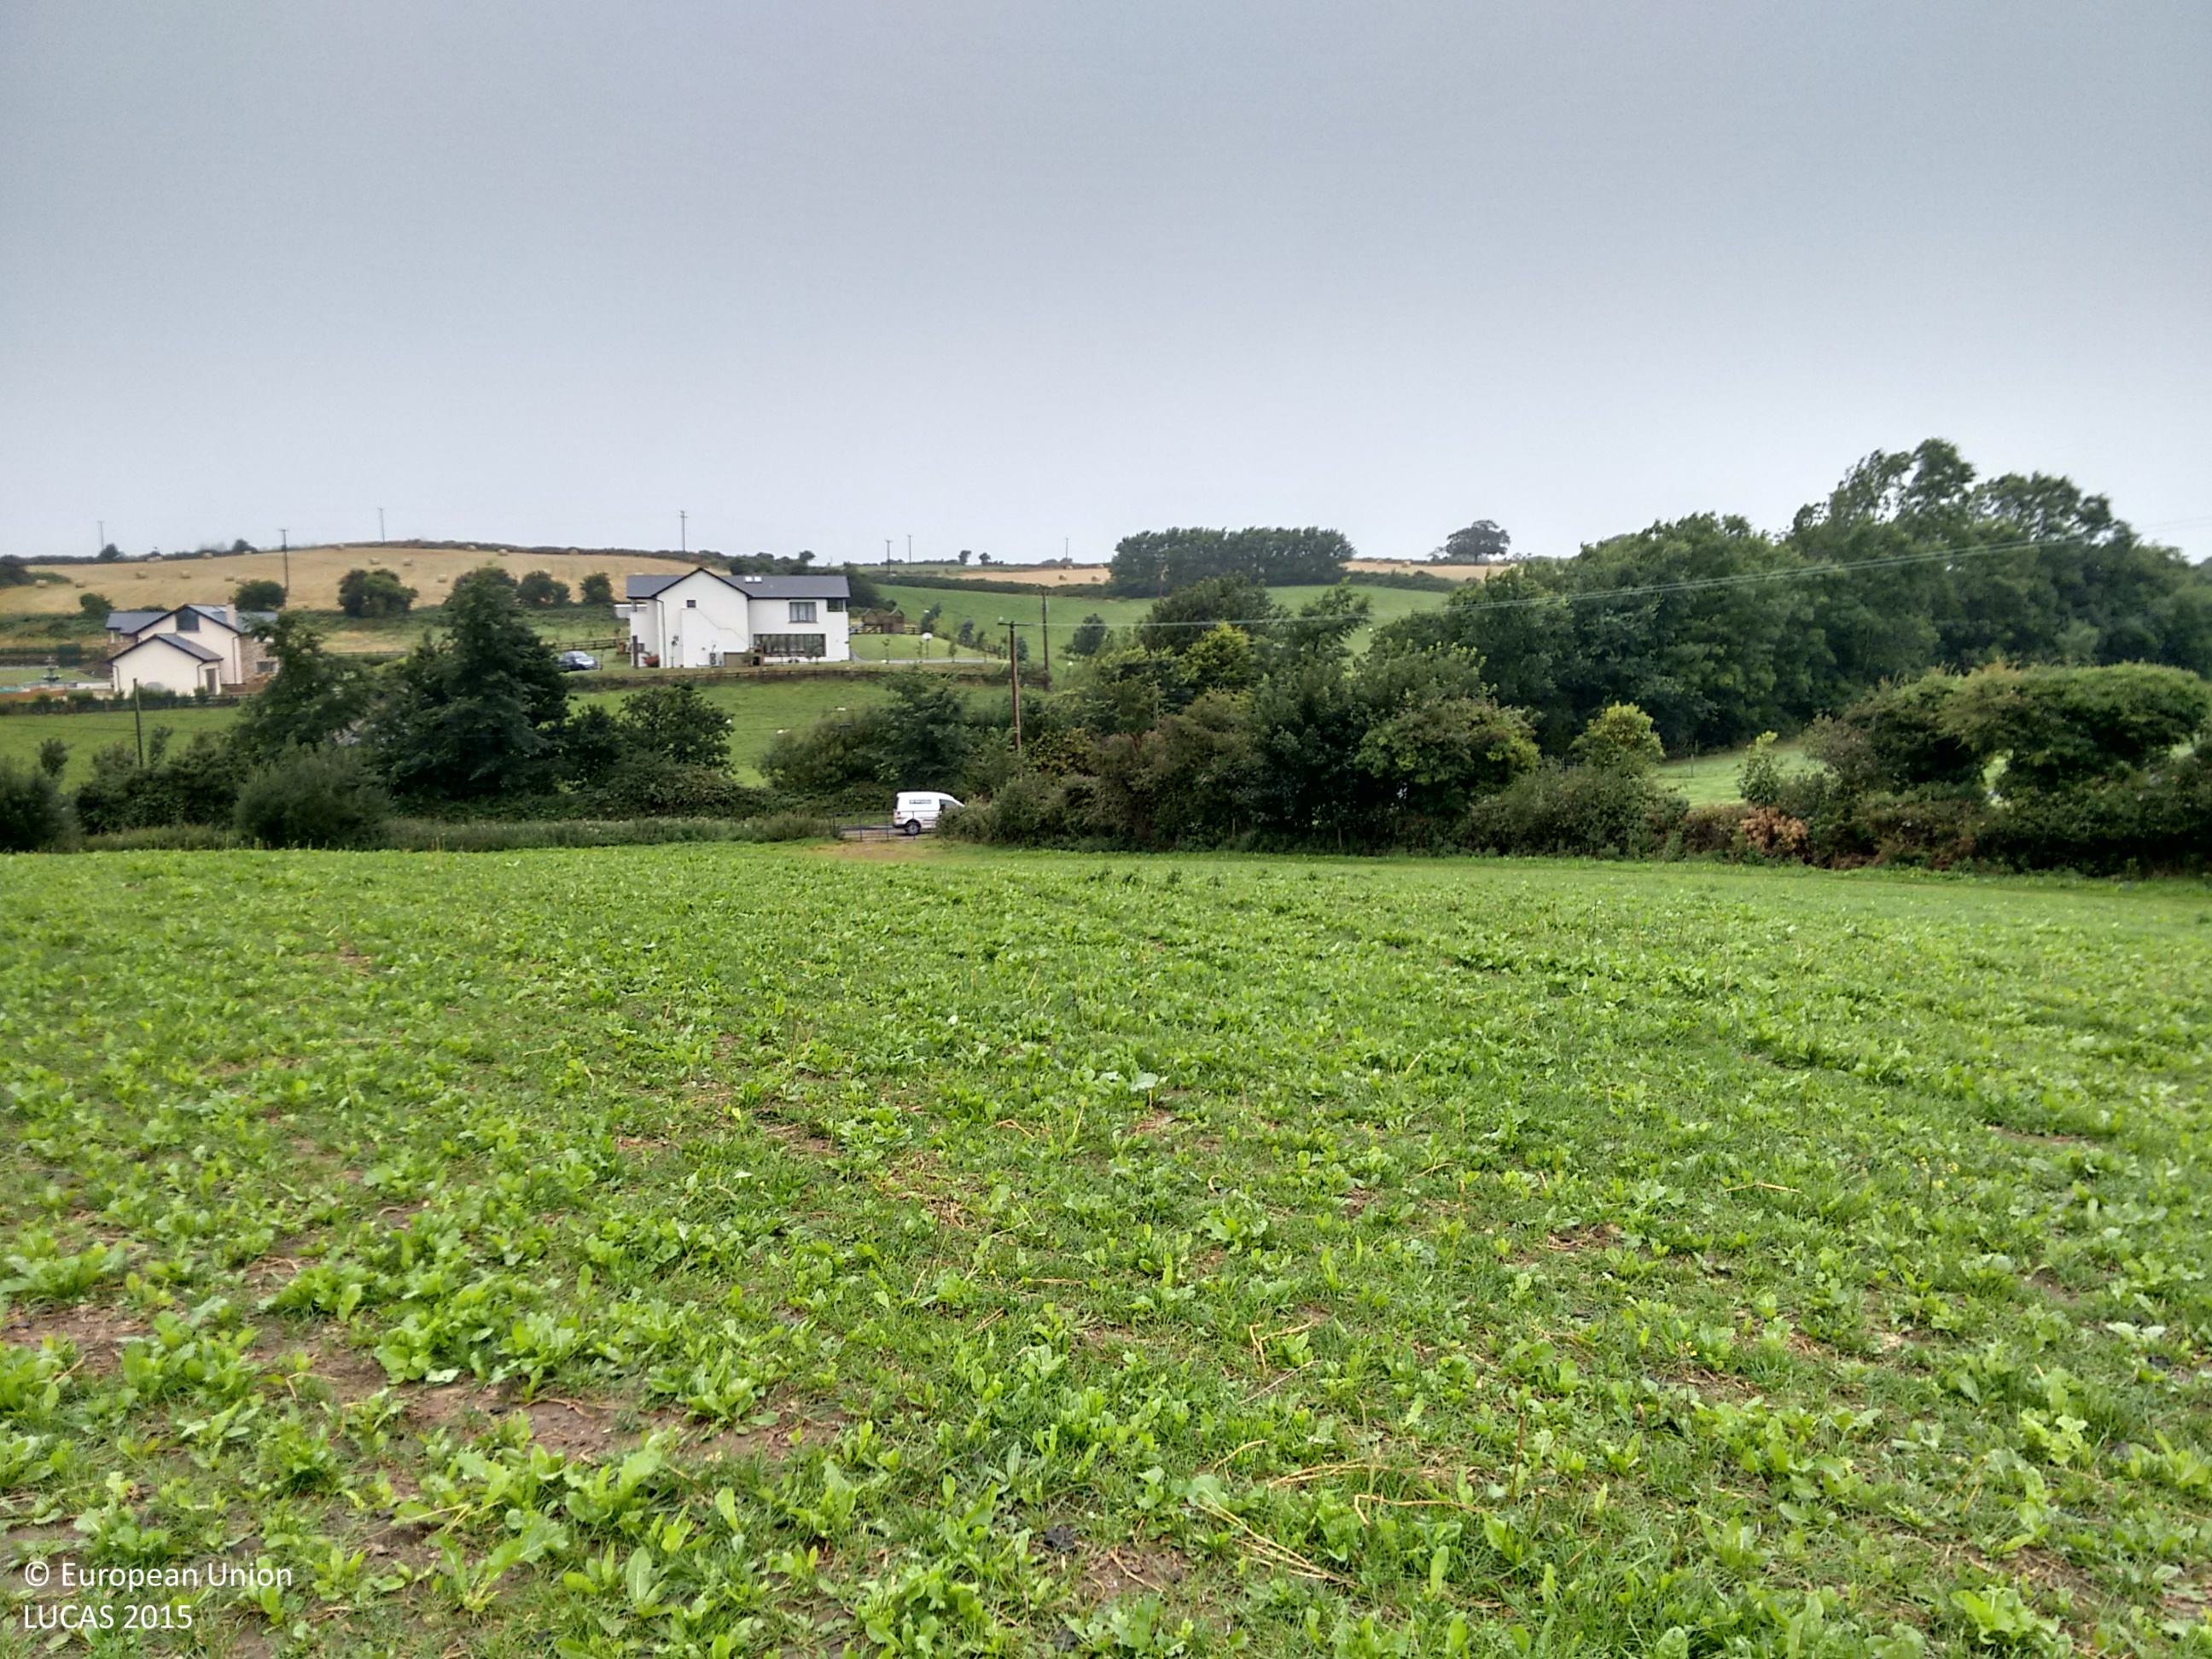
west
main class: Grassland
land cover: Spontaneously vegetated surfaces
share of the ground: > 75 %
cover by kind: herbaceous plants 80 %, unconsolidated bare surface 20 %
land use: Agriculture (excluding fallow land and kitchen gardens)
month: August
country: IE
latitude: 52.4916
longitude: -6.2779
